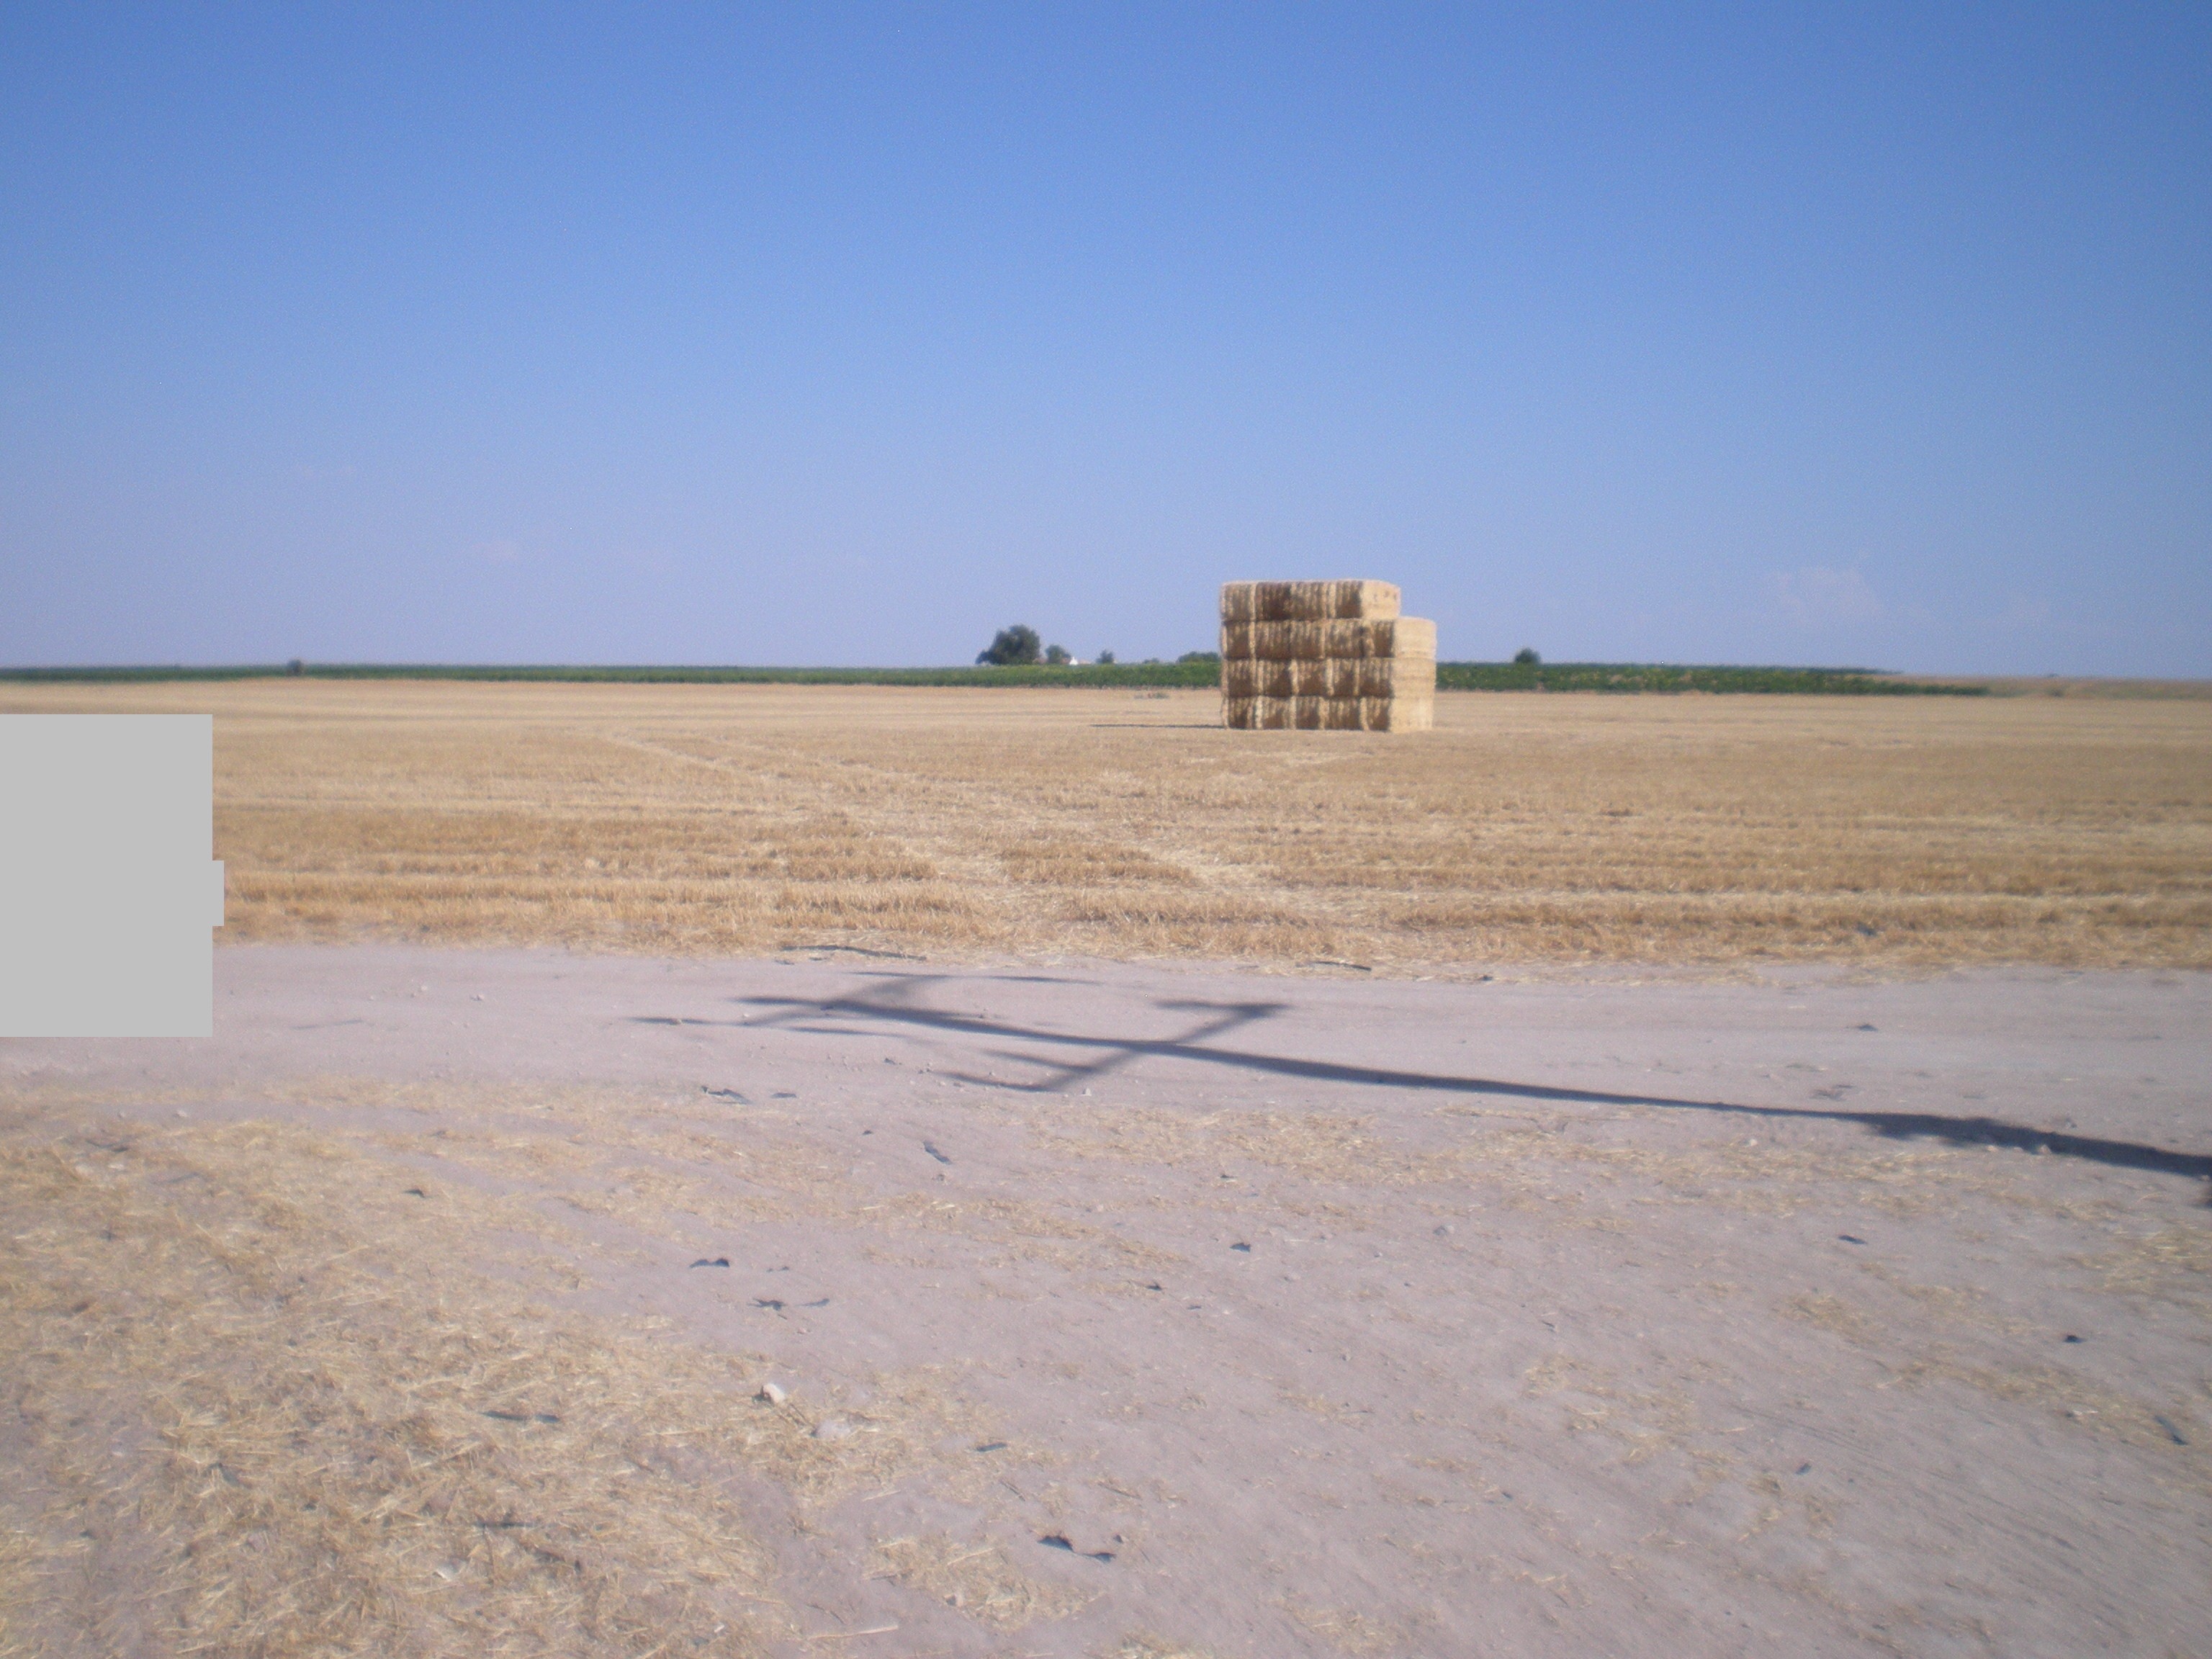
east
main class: Cropland
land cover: Barley
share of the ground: < 10 %
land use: Agriculture (excluding fallow land and kitchen gardens)
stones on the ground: < 10 %
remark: Harvested field
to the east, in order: Barley; Electric lines; Barley; Grass margins; Tracks; Barley; Grass margins; Tracks; Grass margins; Barley
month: July
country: ES
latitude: 39.3103
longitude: -3.1093
